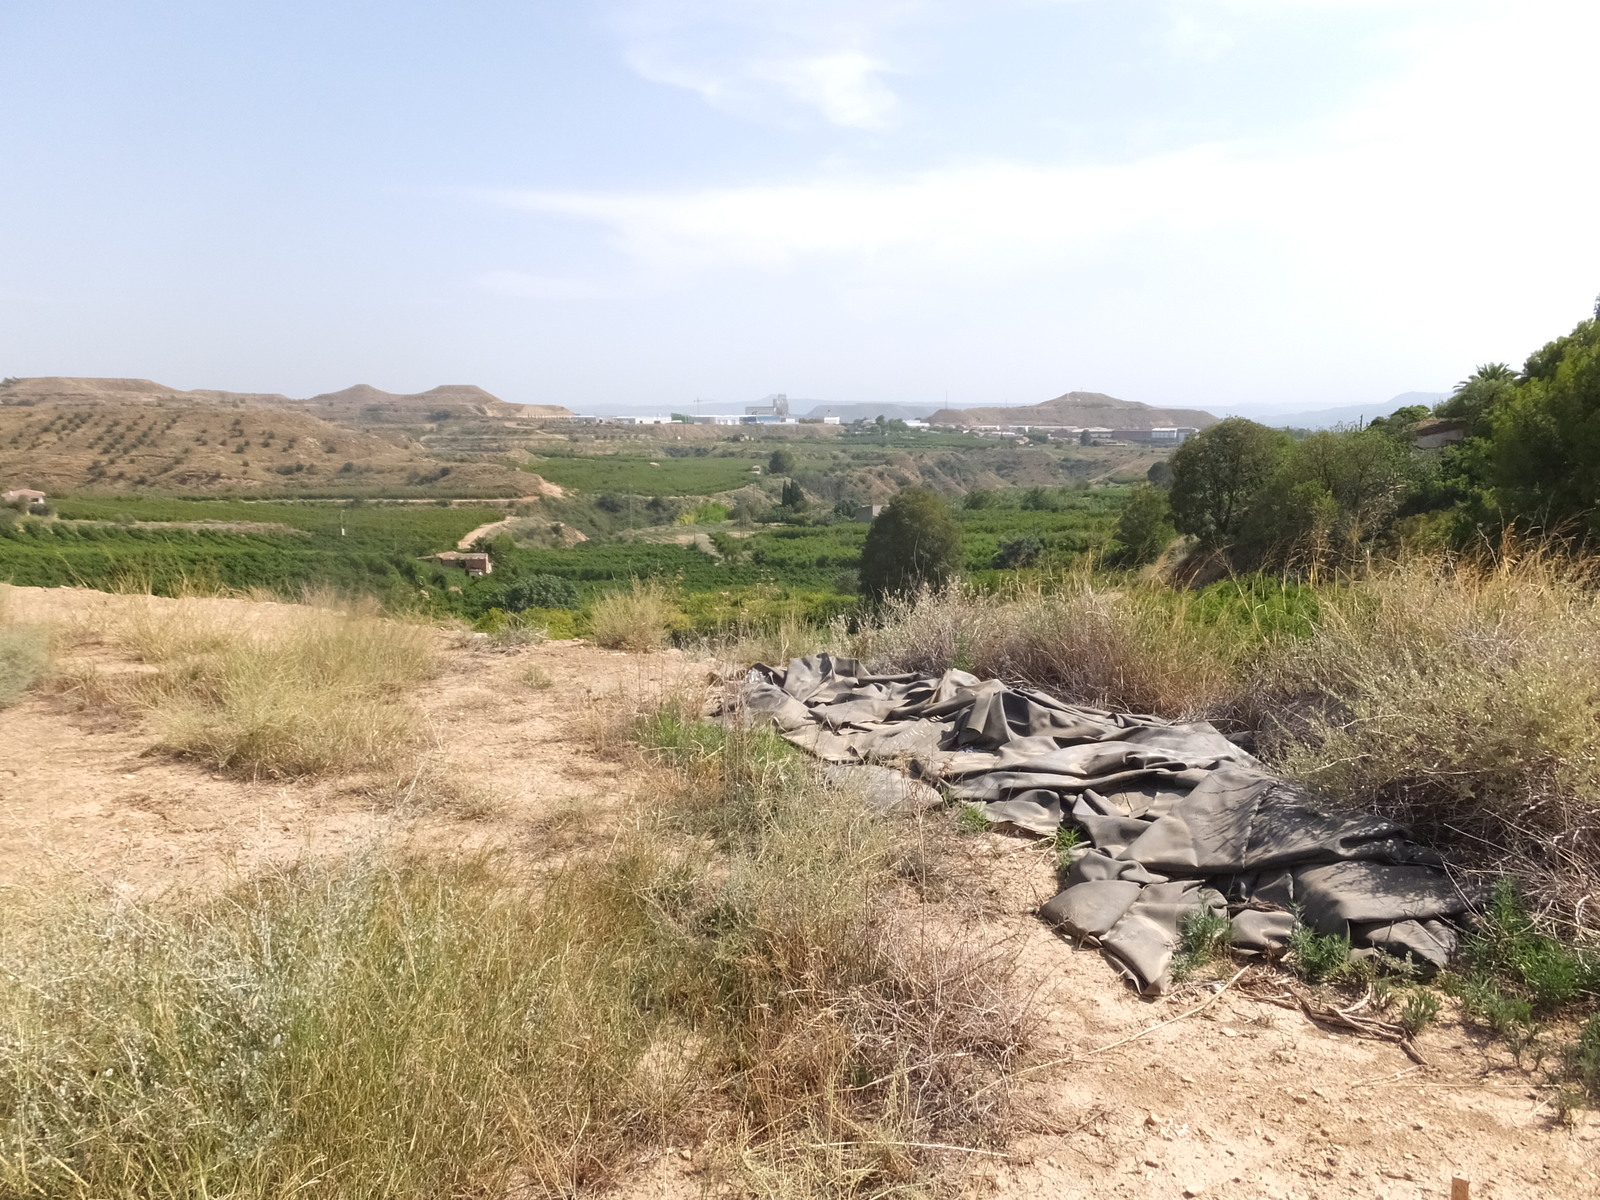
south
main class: Grassland
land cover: Grassland without tree/shrub cover
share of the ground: > 75 %
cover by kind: herbaceous plants 55 %, unconsolidated bare surface 40 %, shrubs 5 %
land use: Semi-natural and natural areas not in use
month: August
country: ES
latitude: 41.5389
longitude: 0.3618
